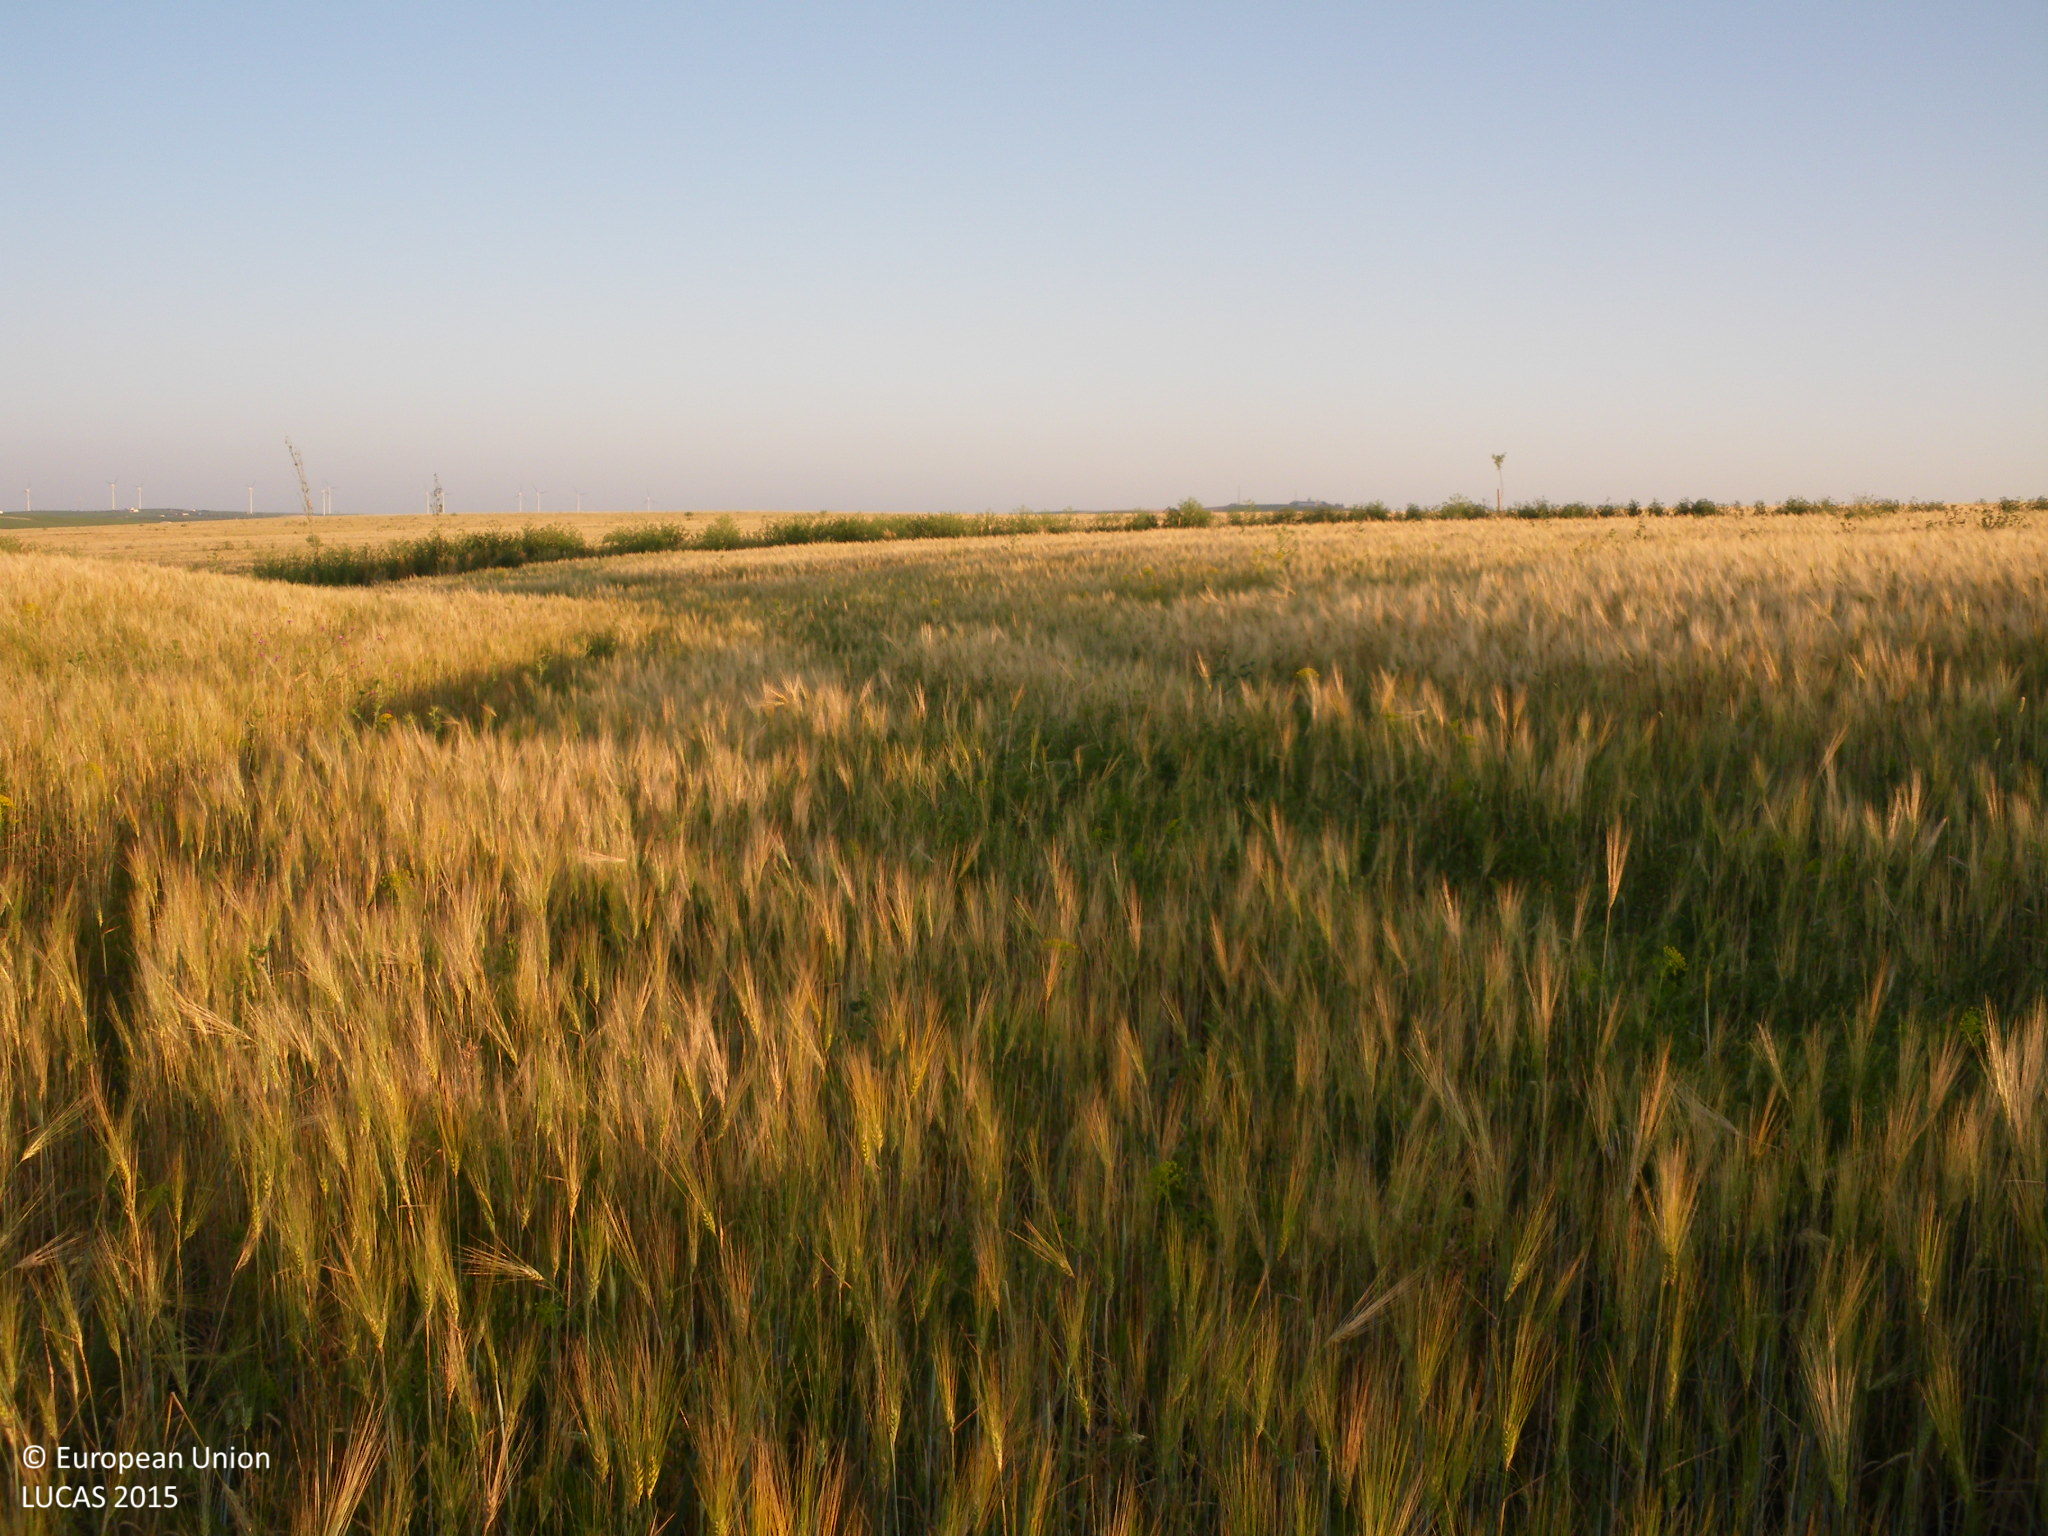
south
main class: Cropland
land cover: Other leguminous and mixtures for fodder
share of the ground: > 75 %
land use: Agriculture (excluding fallow land and kitchen gardens)
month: May
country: ES
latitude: 36.7467
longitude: -6.2440
